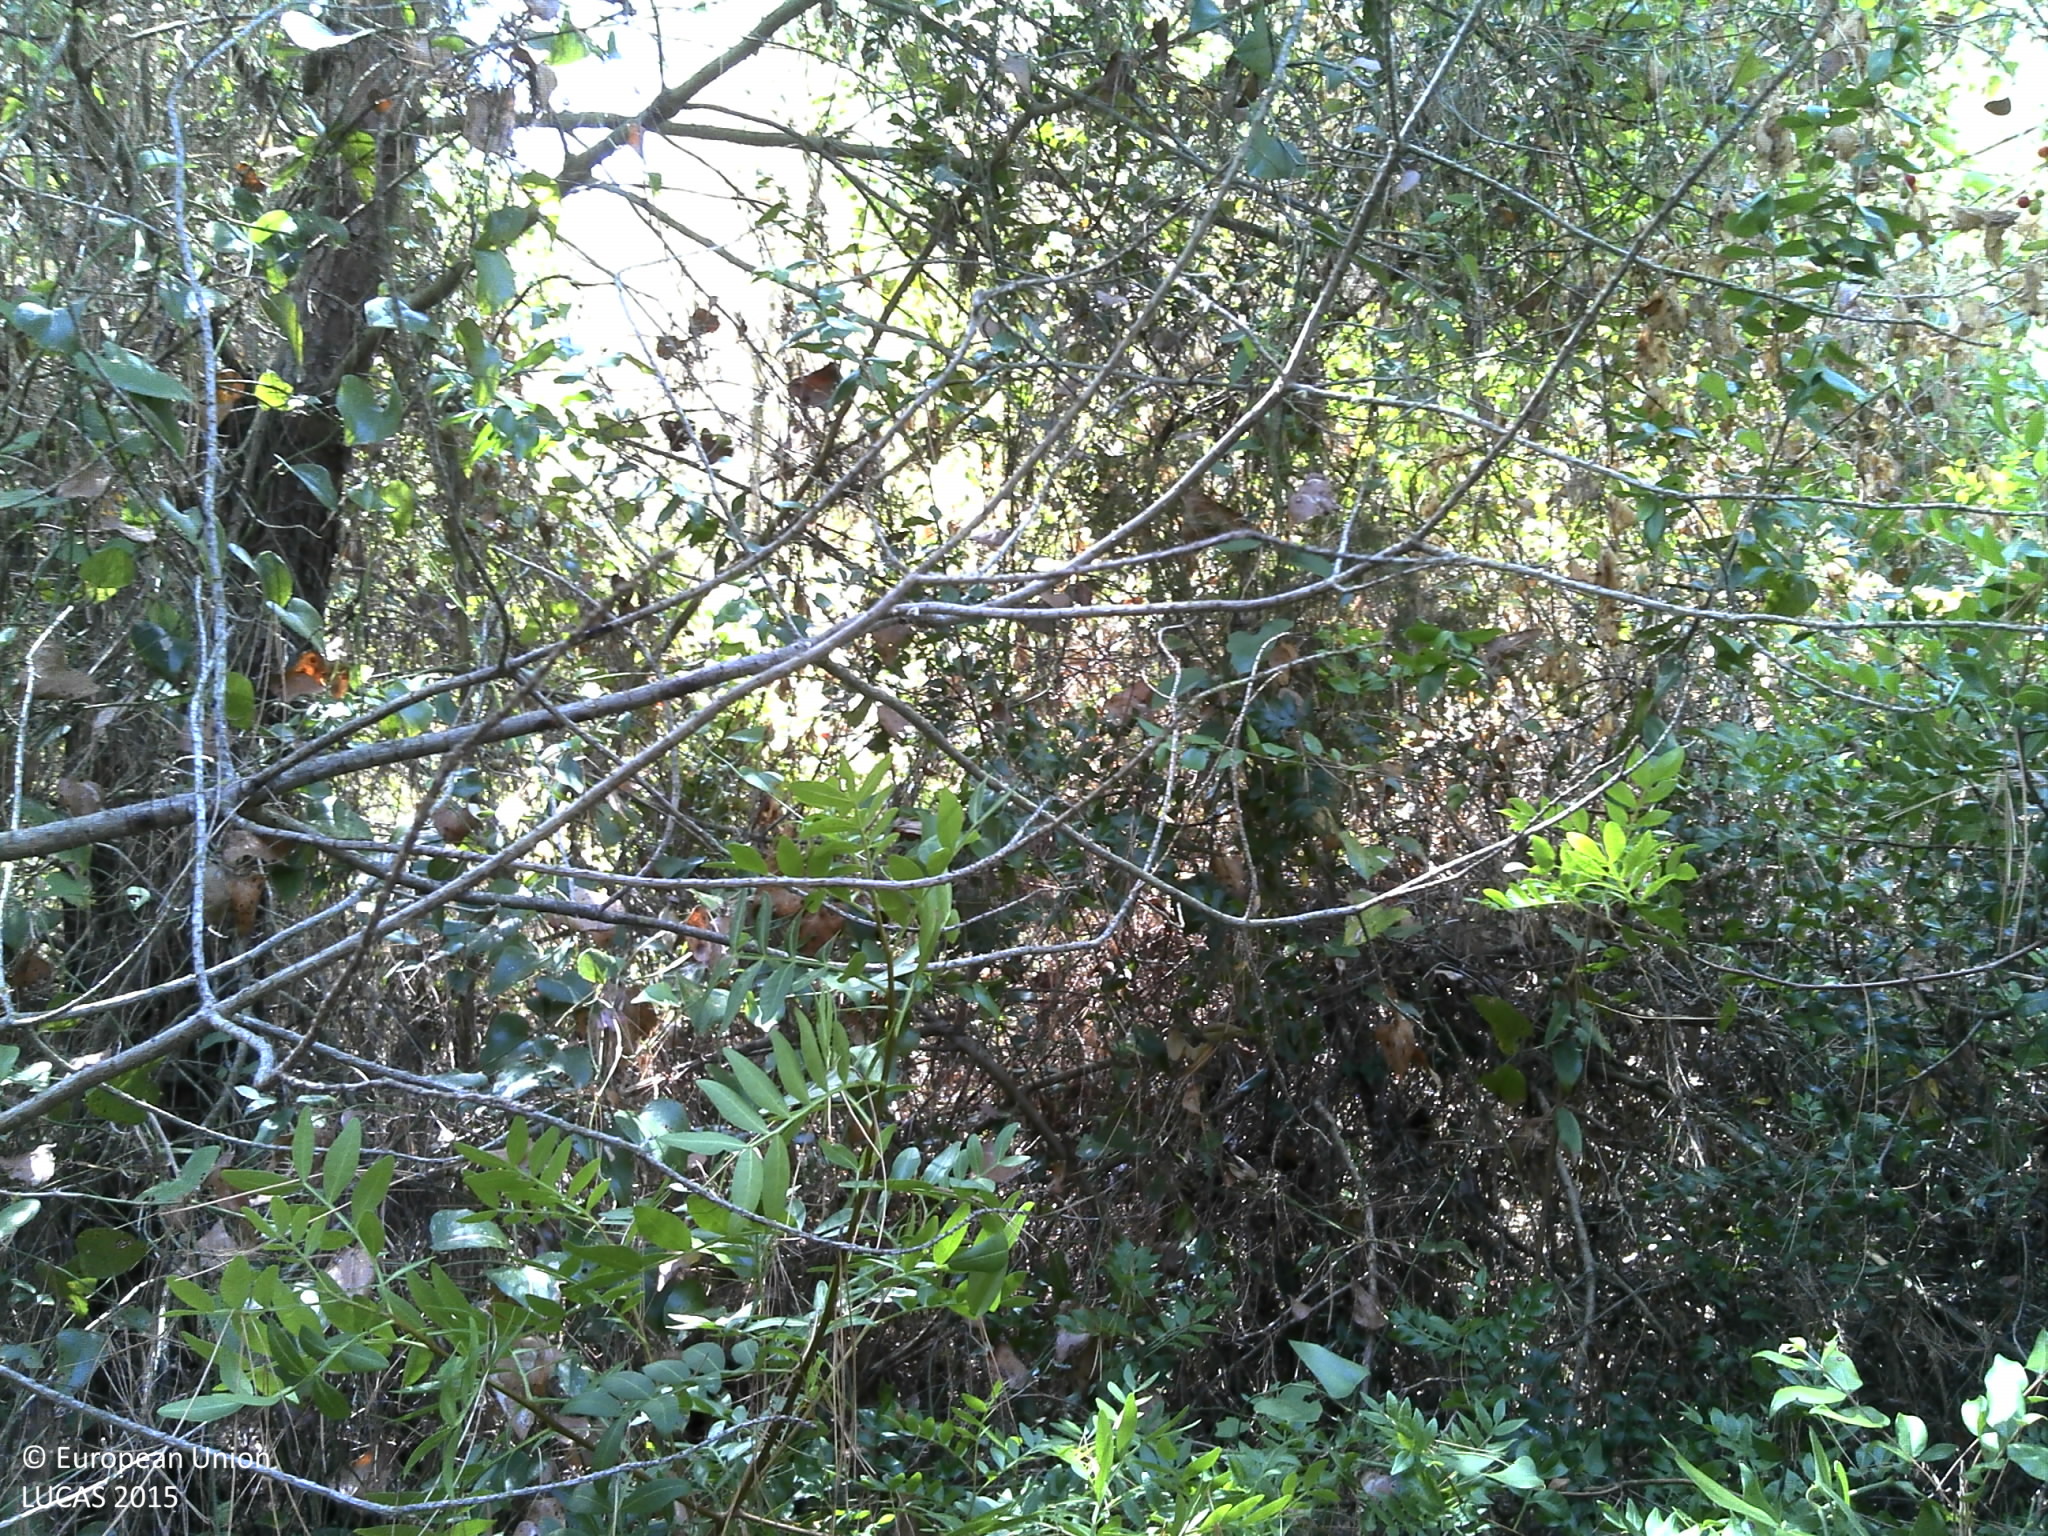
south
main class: Woodland
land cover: Pine dominated coniferous woodland
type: coniferous forest of the mediterranean region
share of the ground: > 75 %
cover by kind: coniferous forest trees 80 %, shrubs 20 %
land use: Semi-natural and natural areas not in use
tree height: > 5 m
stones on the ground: < 10 %
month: July
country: HR
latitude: 43.5071
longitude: 16.3111
